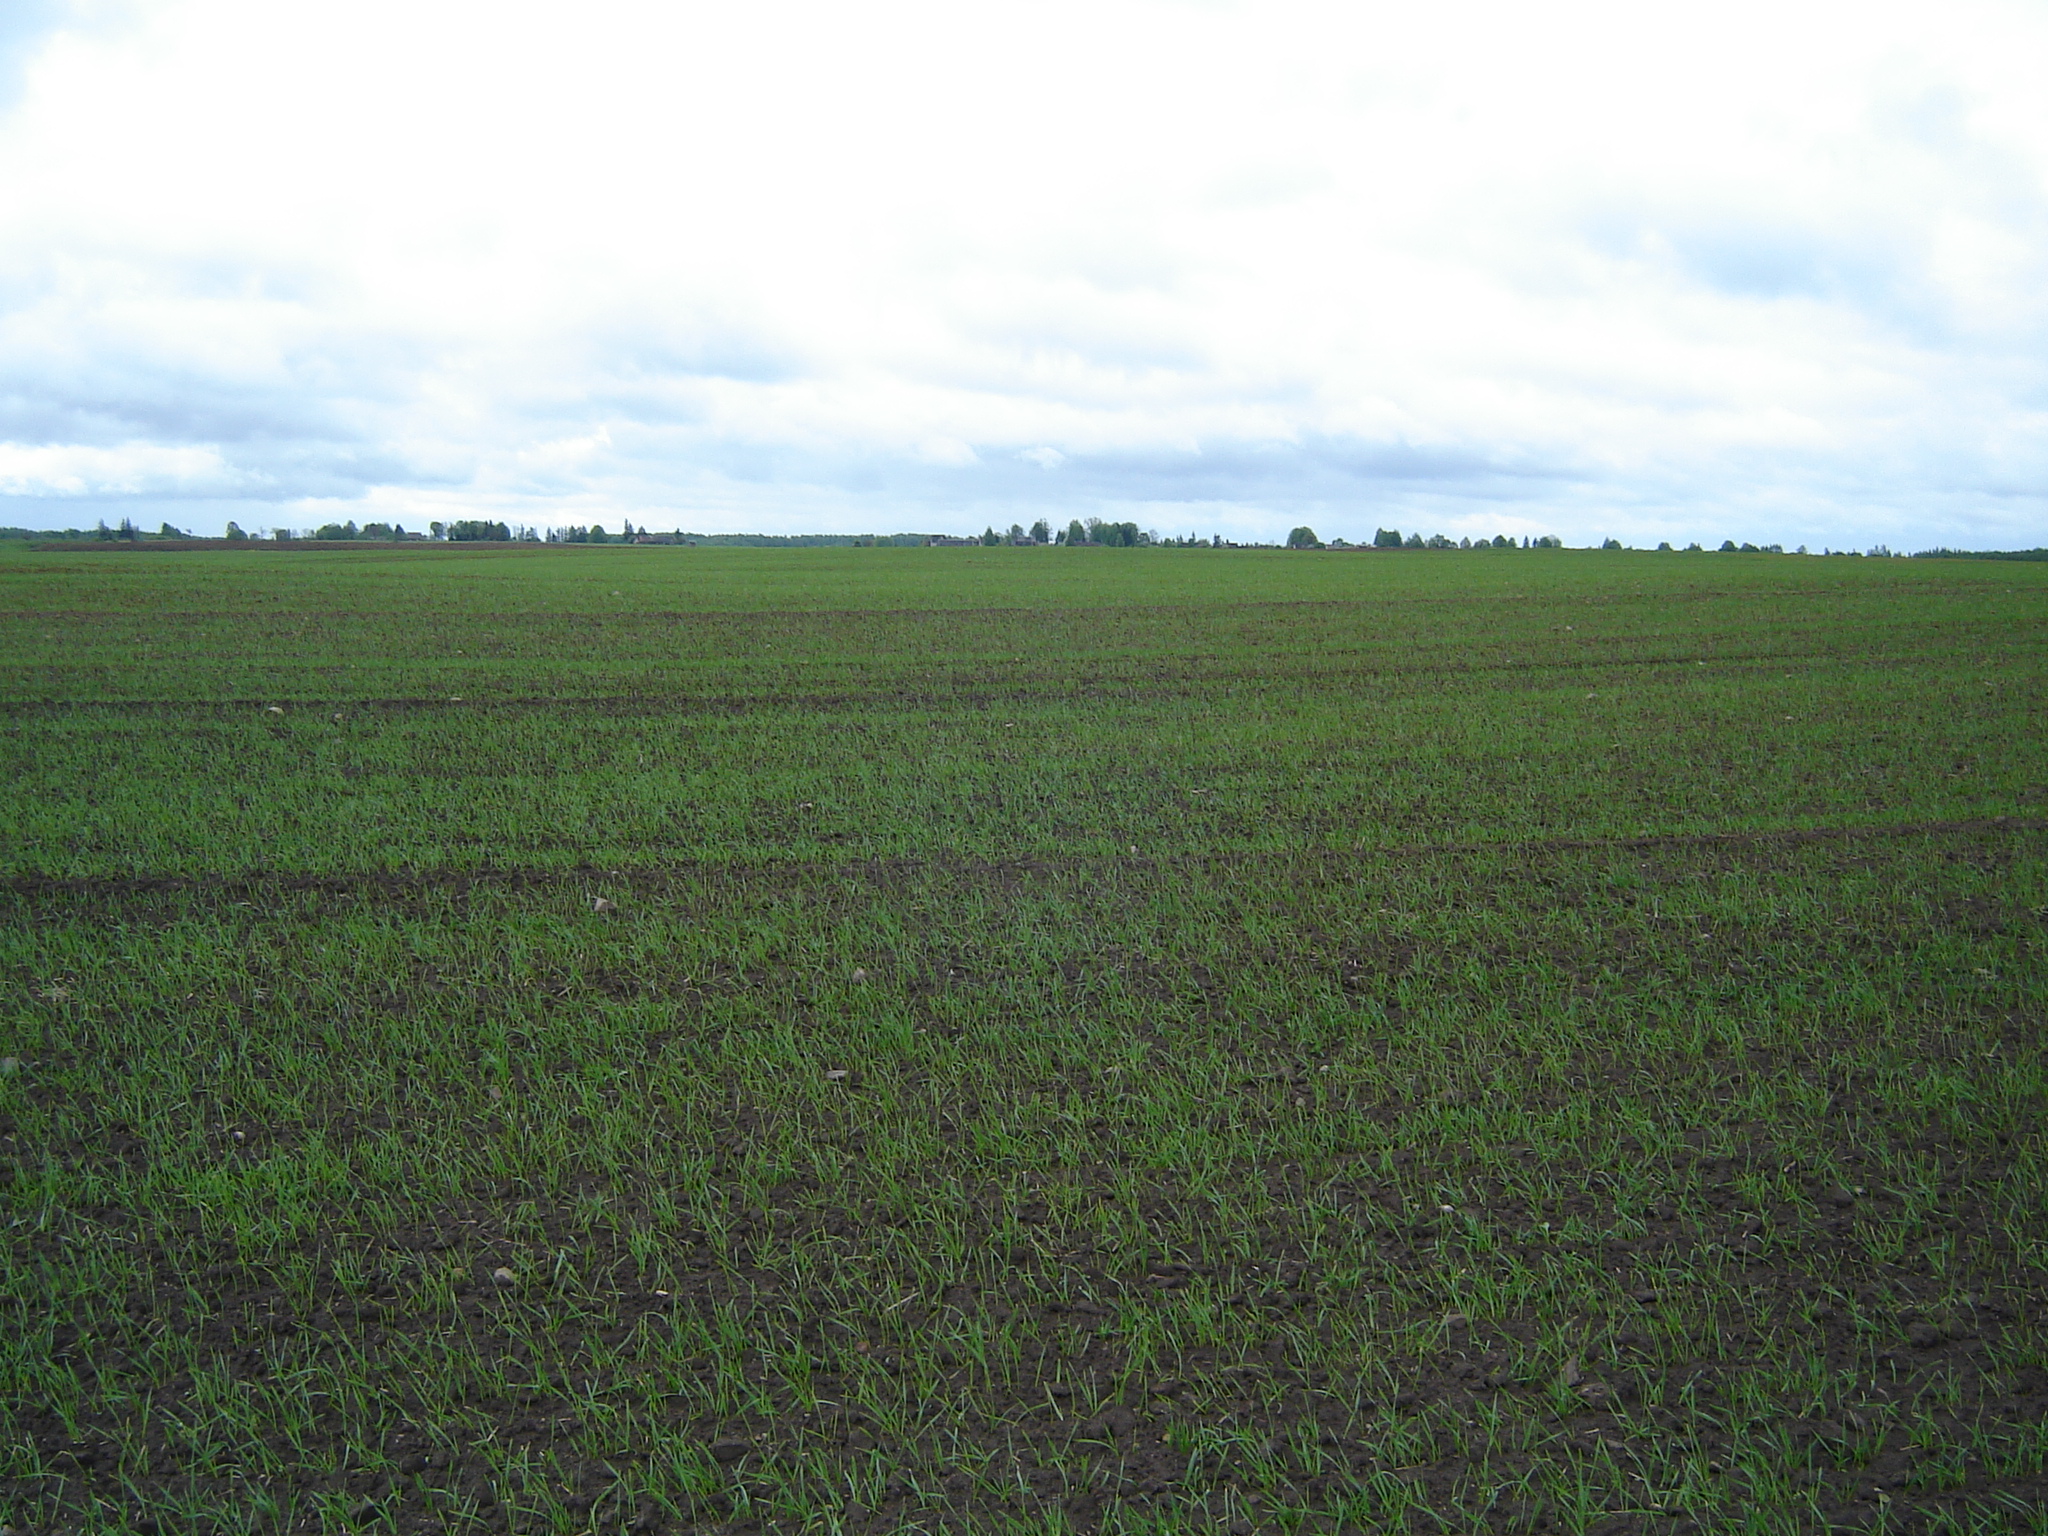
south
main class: Cropland
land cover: Common wheat
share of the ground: 25 - 50 %
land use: Agriculture (excluding fallow land and kitchen gardens)
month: May
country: LT
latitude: 56.0384
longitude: 25.2517
